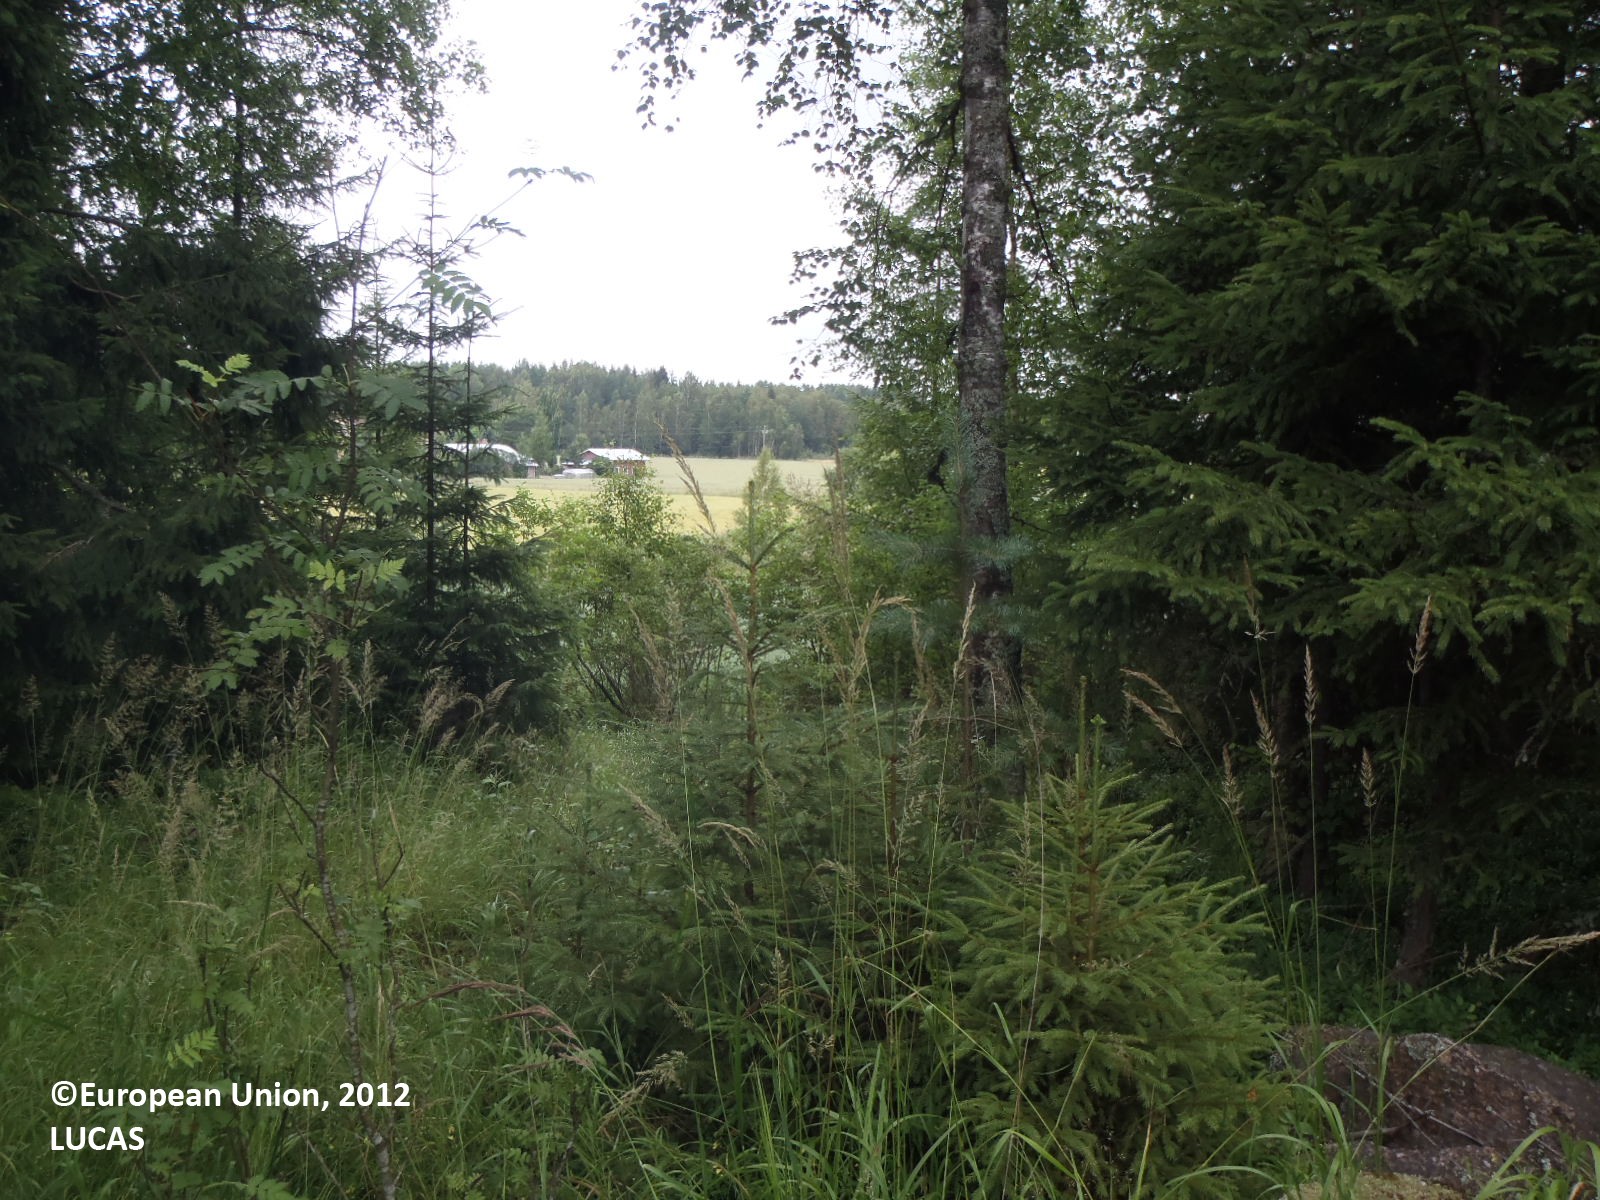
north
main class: Woodland
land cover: Other mixed woodland
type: boreal forest
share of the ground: > 75 %
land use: Forestry
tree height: > 5 m
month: July
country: FI
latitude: 60.7782
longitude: 21.7926
